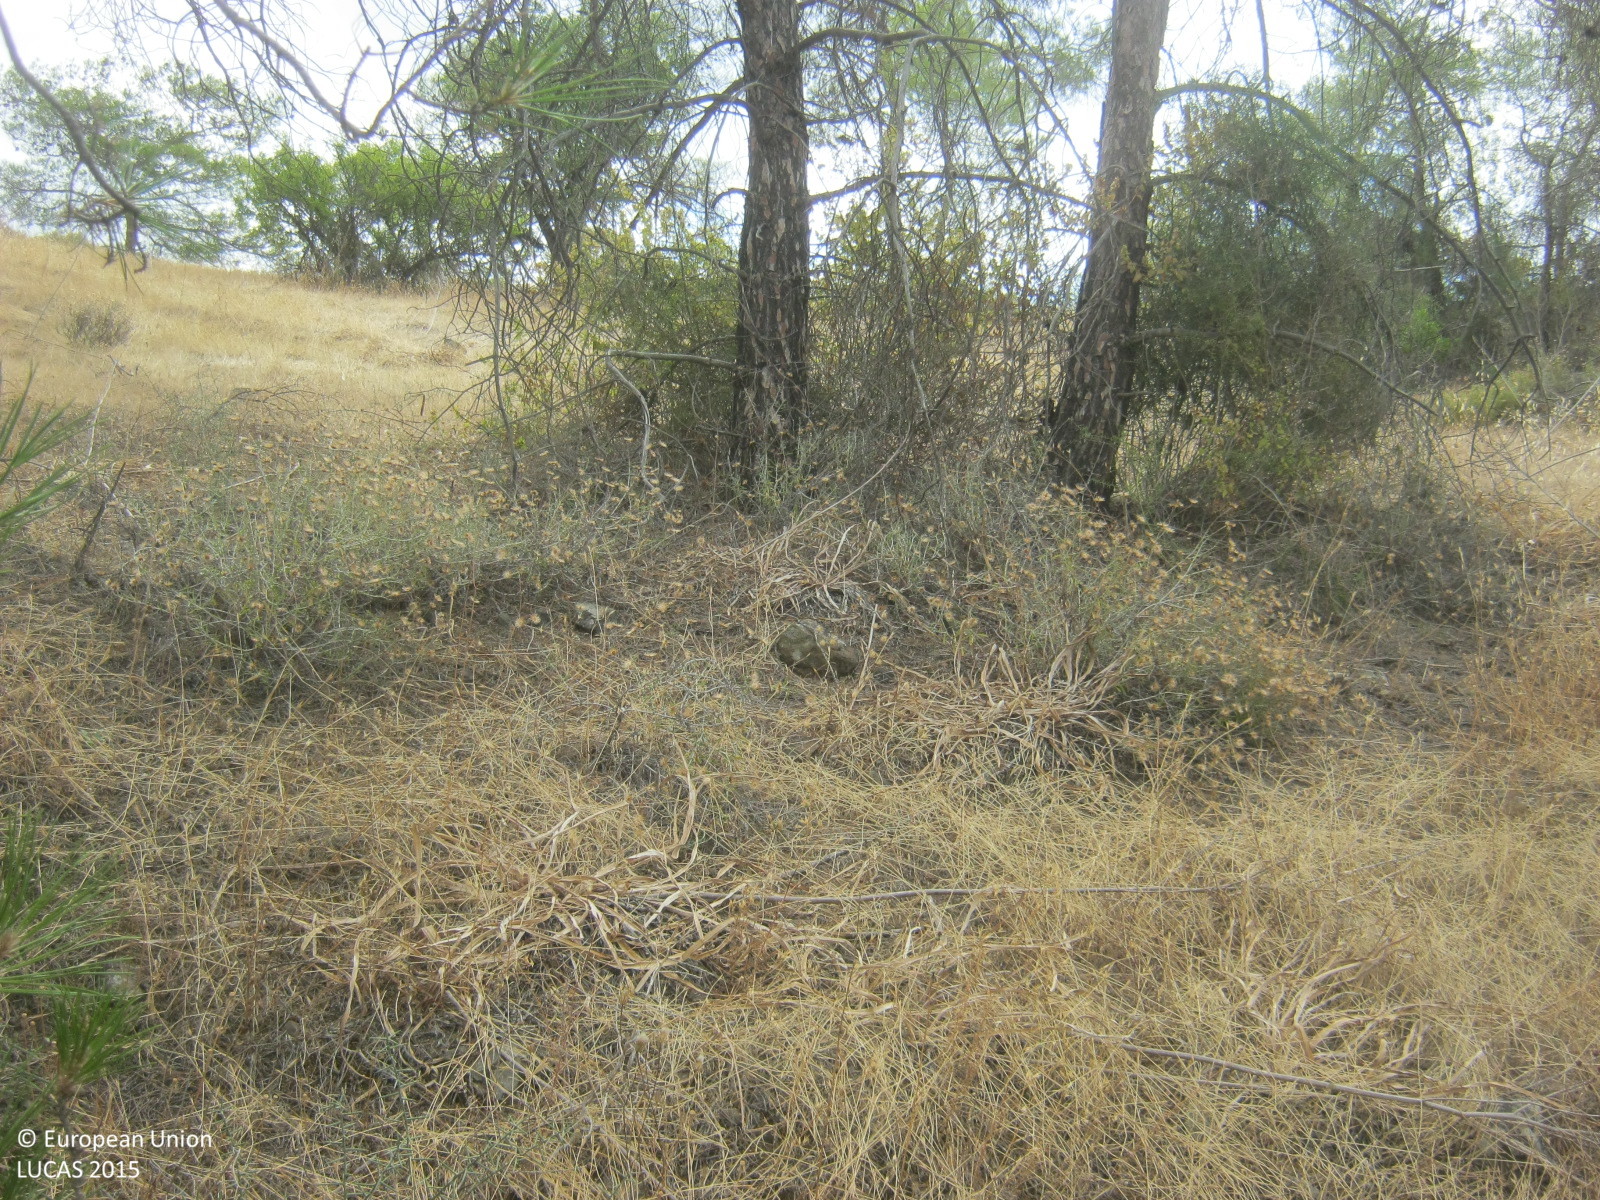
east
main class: Woodland
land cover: Pine dominated coniferous woodland
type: coniferous forest of the mediterranean region
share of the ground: 50 - 75 %
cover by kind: coniferous forest trees 70 %, shrubs 15 %, herbaceous plants 15 %
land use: Forestry
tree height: > 5 m
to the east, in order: Pine dominated coniferous woodland; Rivers and streams; Pine dominated coniferous woodland; Rivers and streams; Pine dominated coniferous woodland
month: June
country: CY
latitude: 35.0691
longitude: 32.9506
